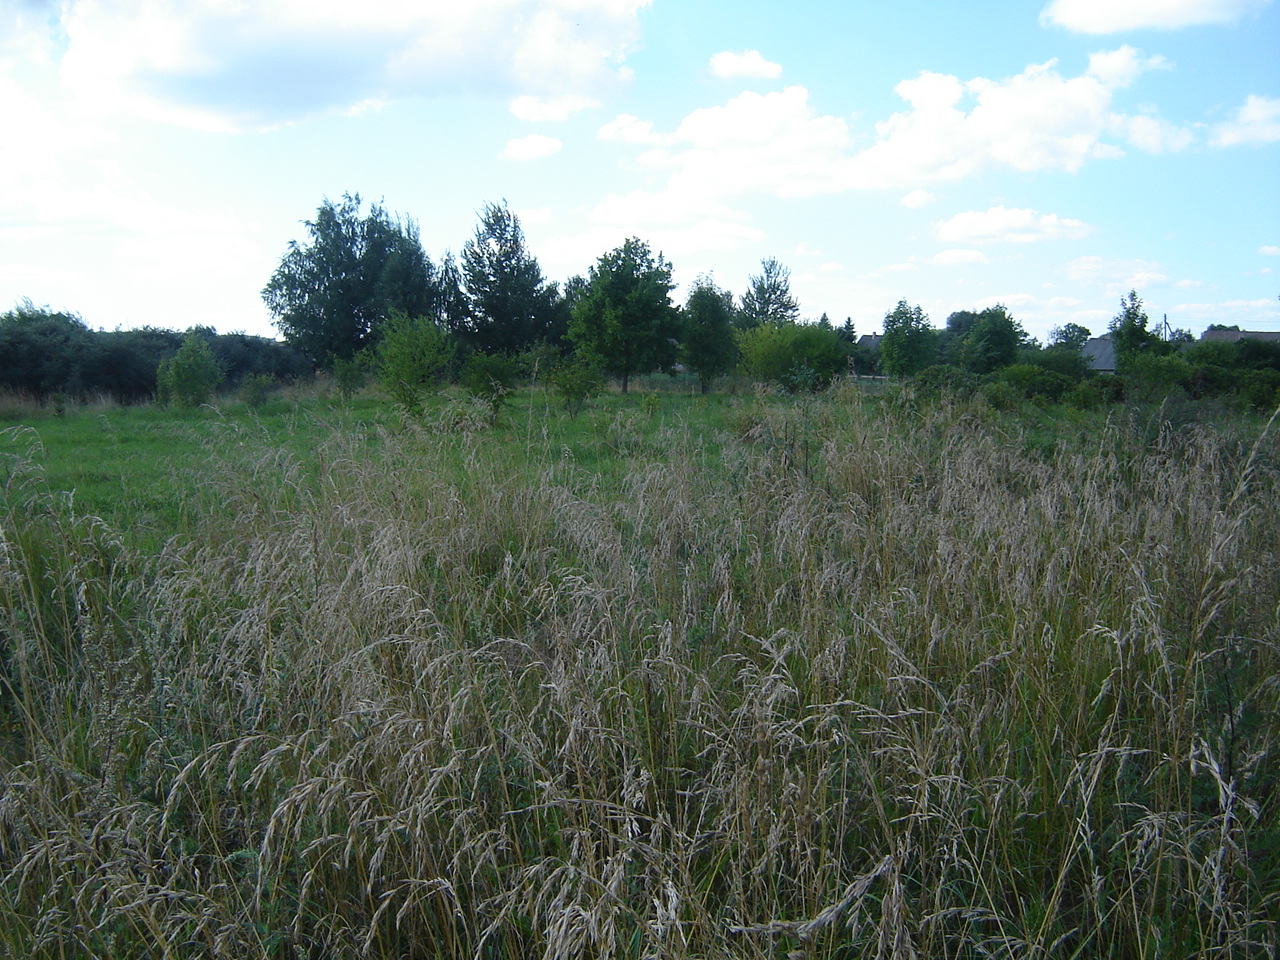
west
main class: Grassland
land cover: Spontaneously vegetated surfaces
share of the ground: > 75 %
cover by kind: herbaceous plants 95 %, shrubs 5 %
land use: Abandoned areas
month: August
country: LT
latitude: 55.0187
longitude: 24.8909
